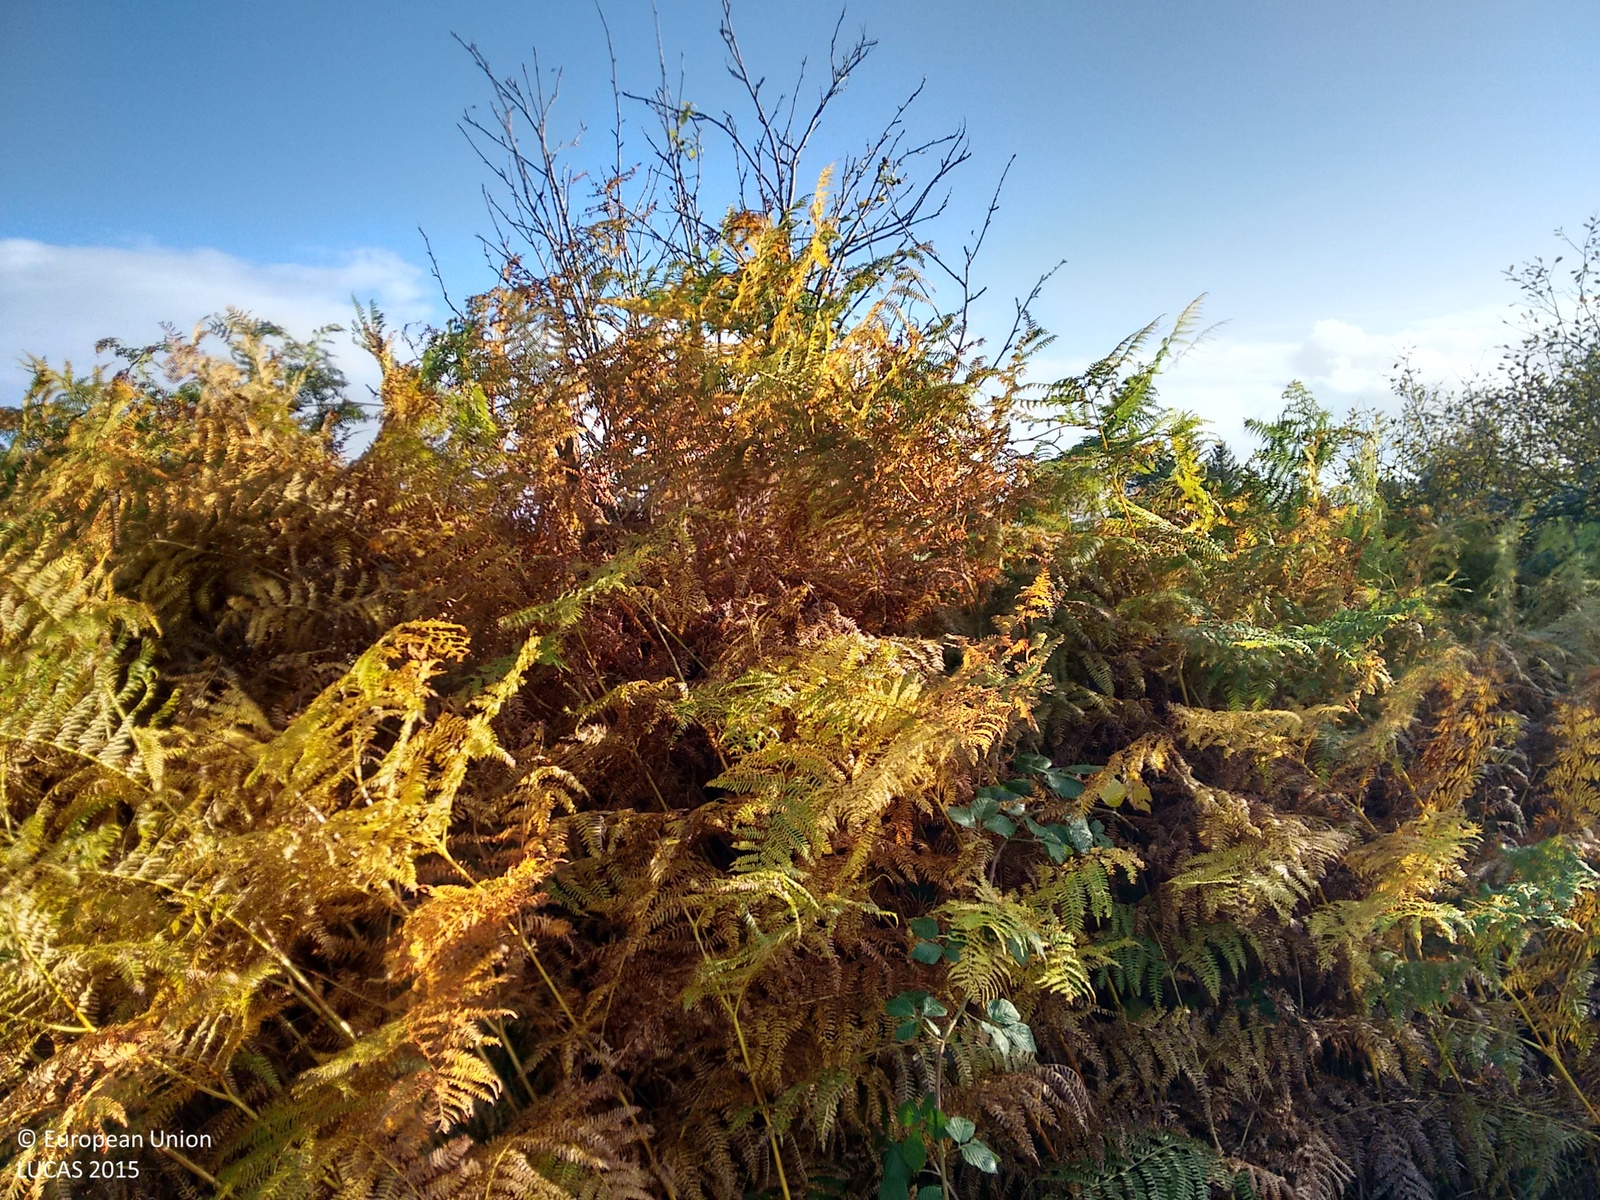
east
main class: Grassland
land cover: Grassland without tree/shrub cover
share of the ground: > 75 %
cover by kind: herbaceous plants 100 %
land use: Agriculture (excluding fallow land and kitchen gardens)
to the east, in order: Grassland without tree/shrub cover; Abandoned hedges; Grassland without tree/shrub cover; Abandoned hedges; Grassland without tree/shrub cover; Abandoned hedges; Grassland without tree/shrub cover; Broadleaved woodland; Grassland without tree/shrub cover
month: October
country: IE
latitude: 53.9821
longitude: -8.3168
